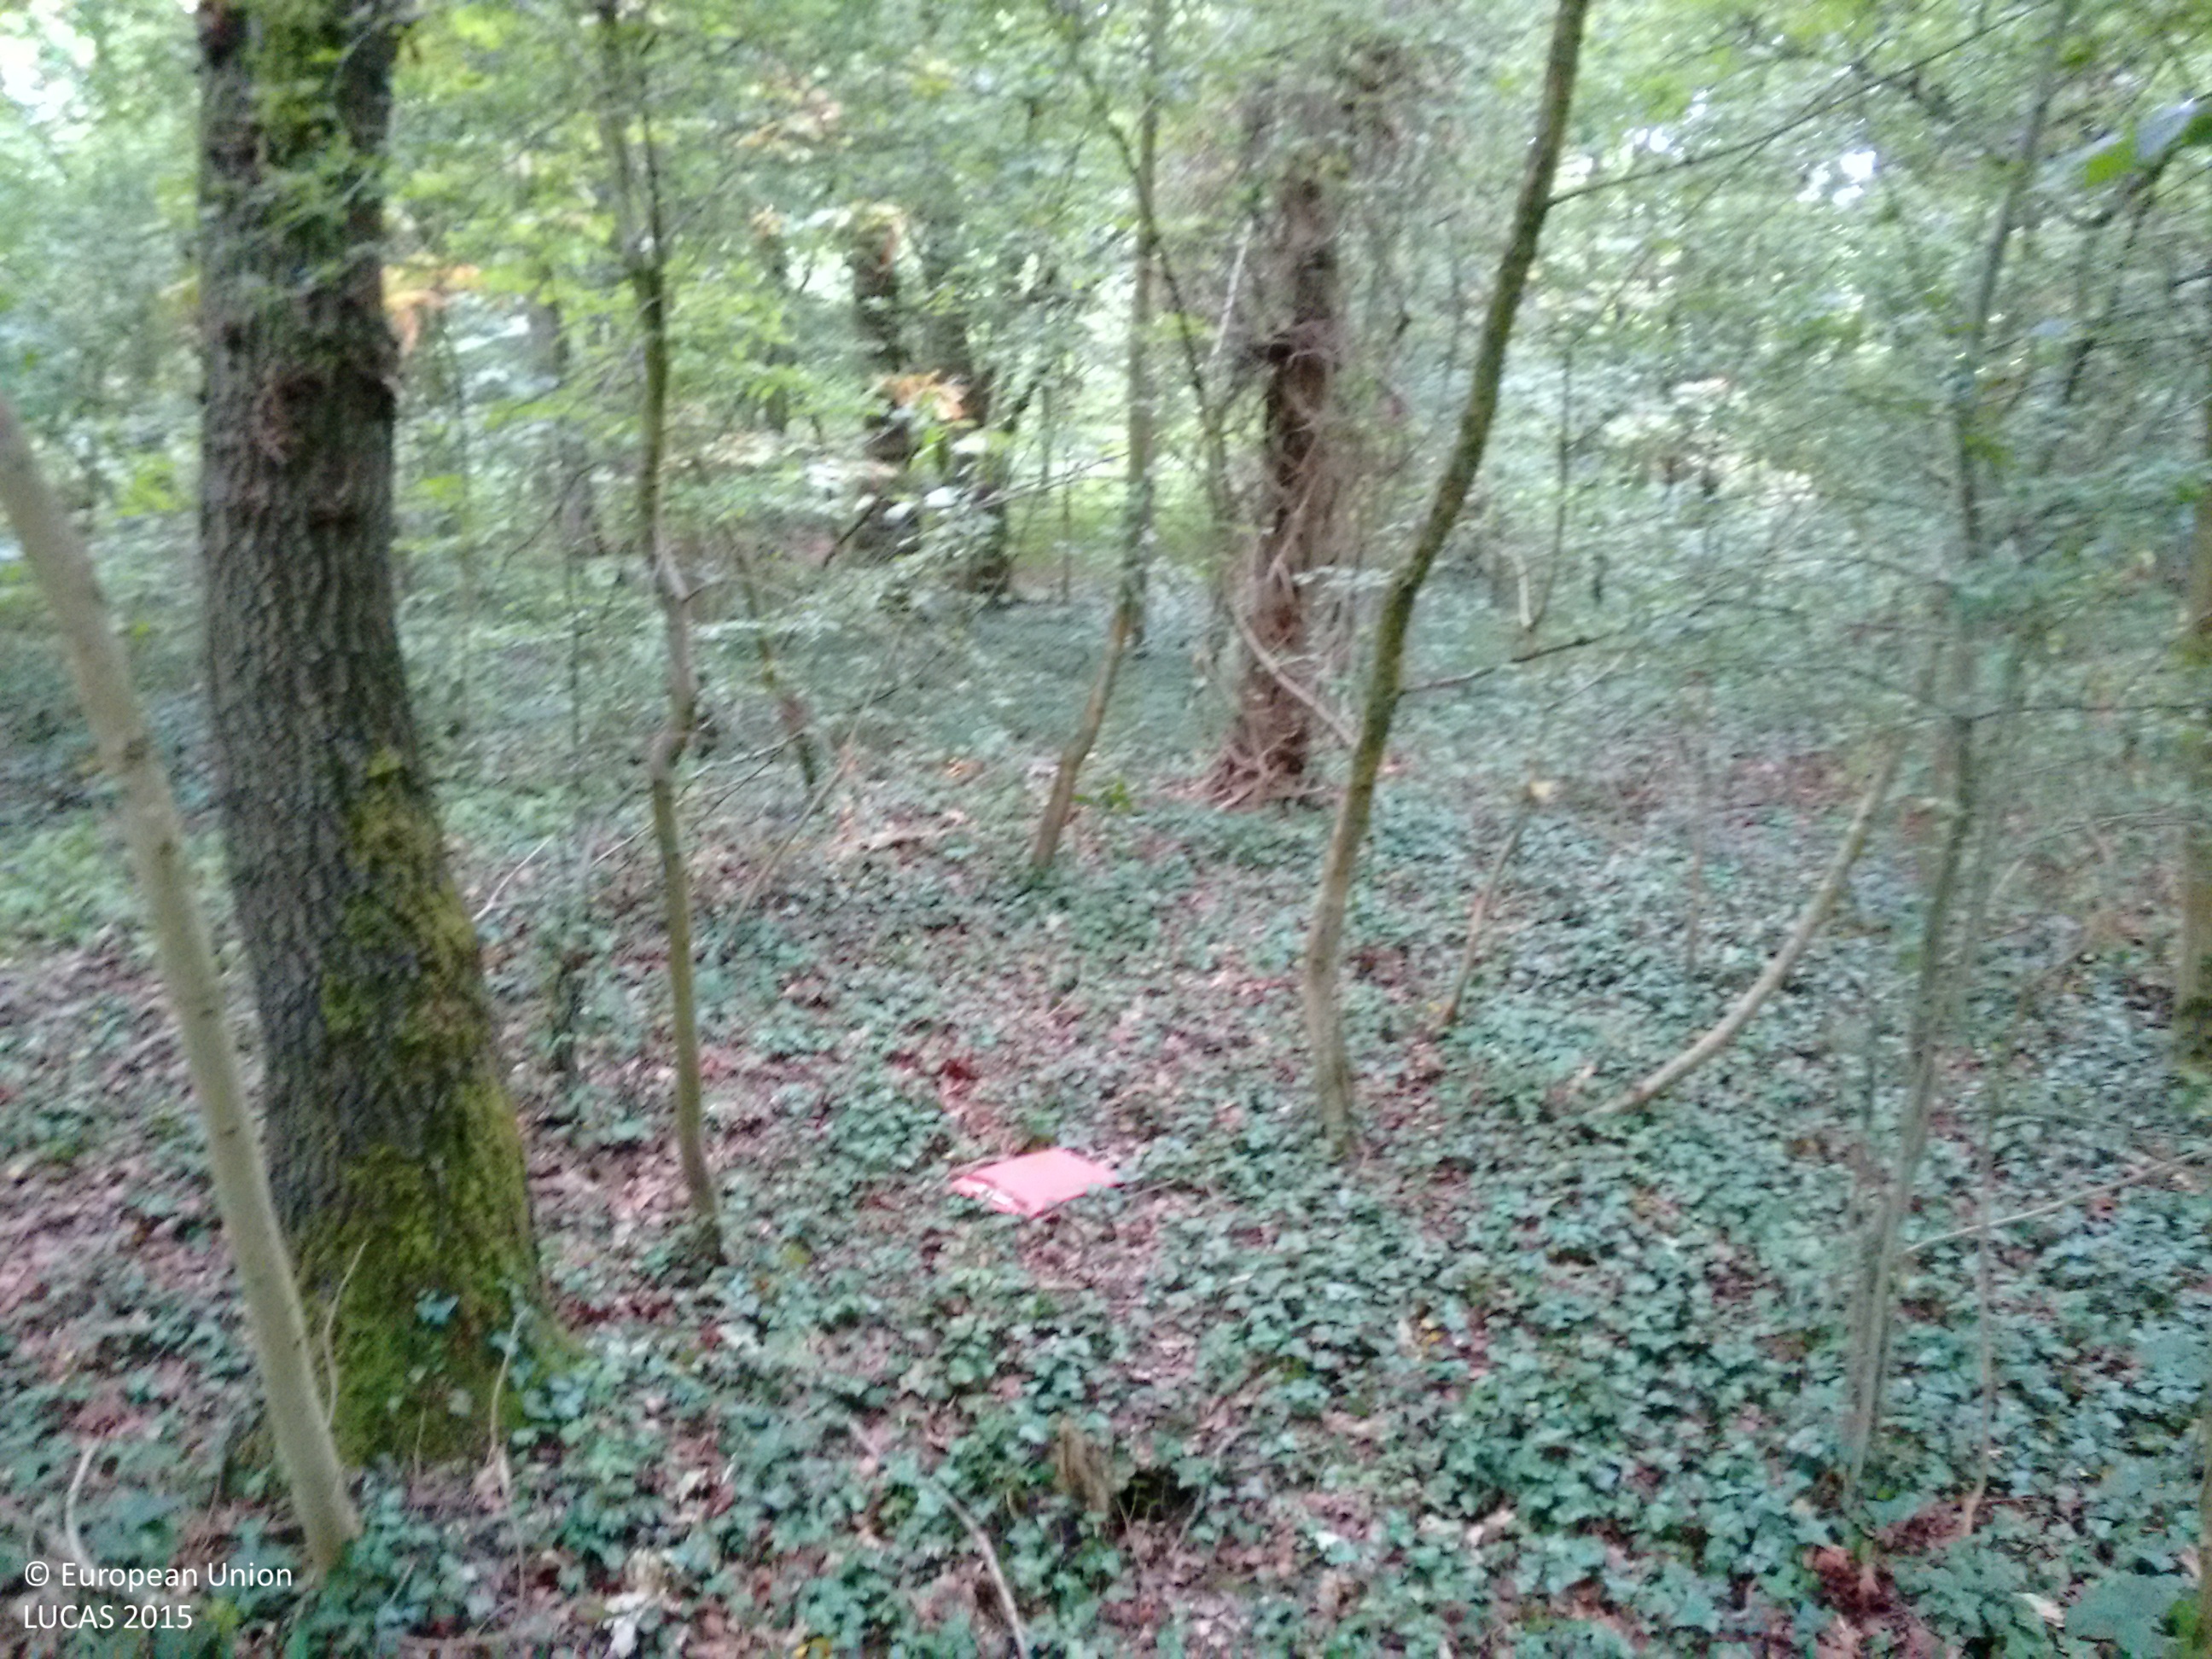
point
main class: Woodland
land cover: Broadleaved woodland
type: mesophytic deciduous forest
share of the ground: > 75 %
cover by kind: broadleaved forest trees 80 %, shrubs 15 %, herbaceous plants 5 %
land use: Amenities, museums, leisure
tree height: > 5 m
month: July
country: GB
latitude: 51.3124
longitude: -0.2938
